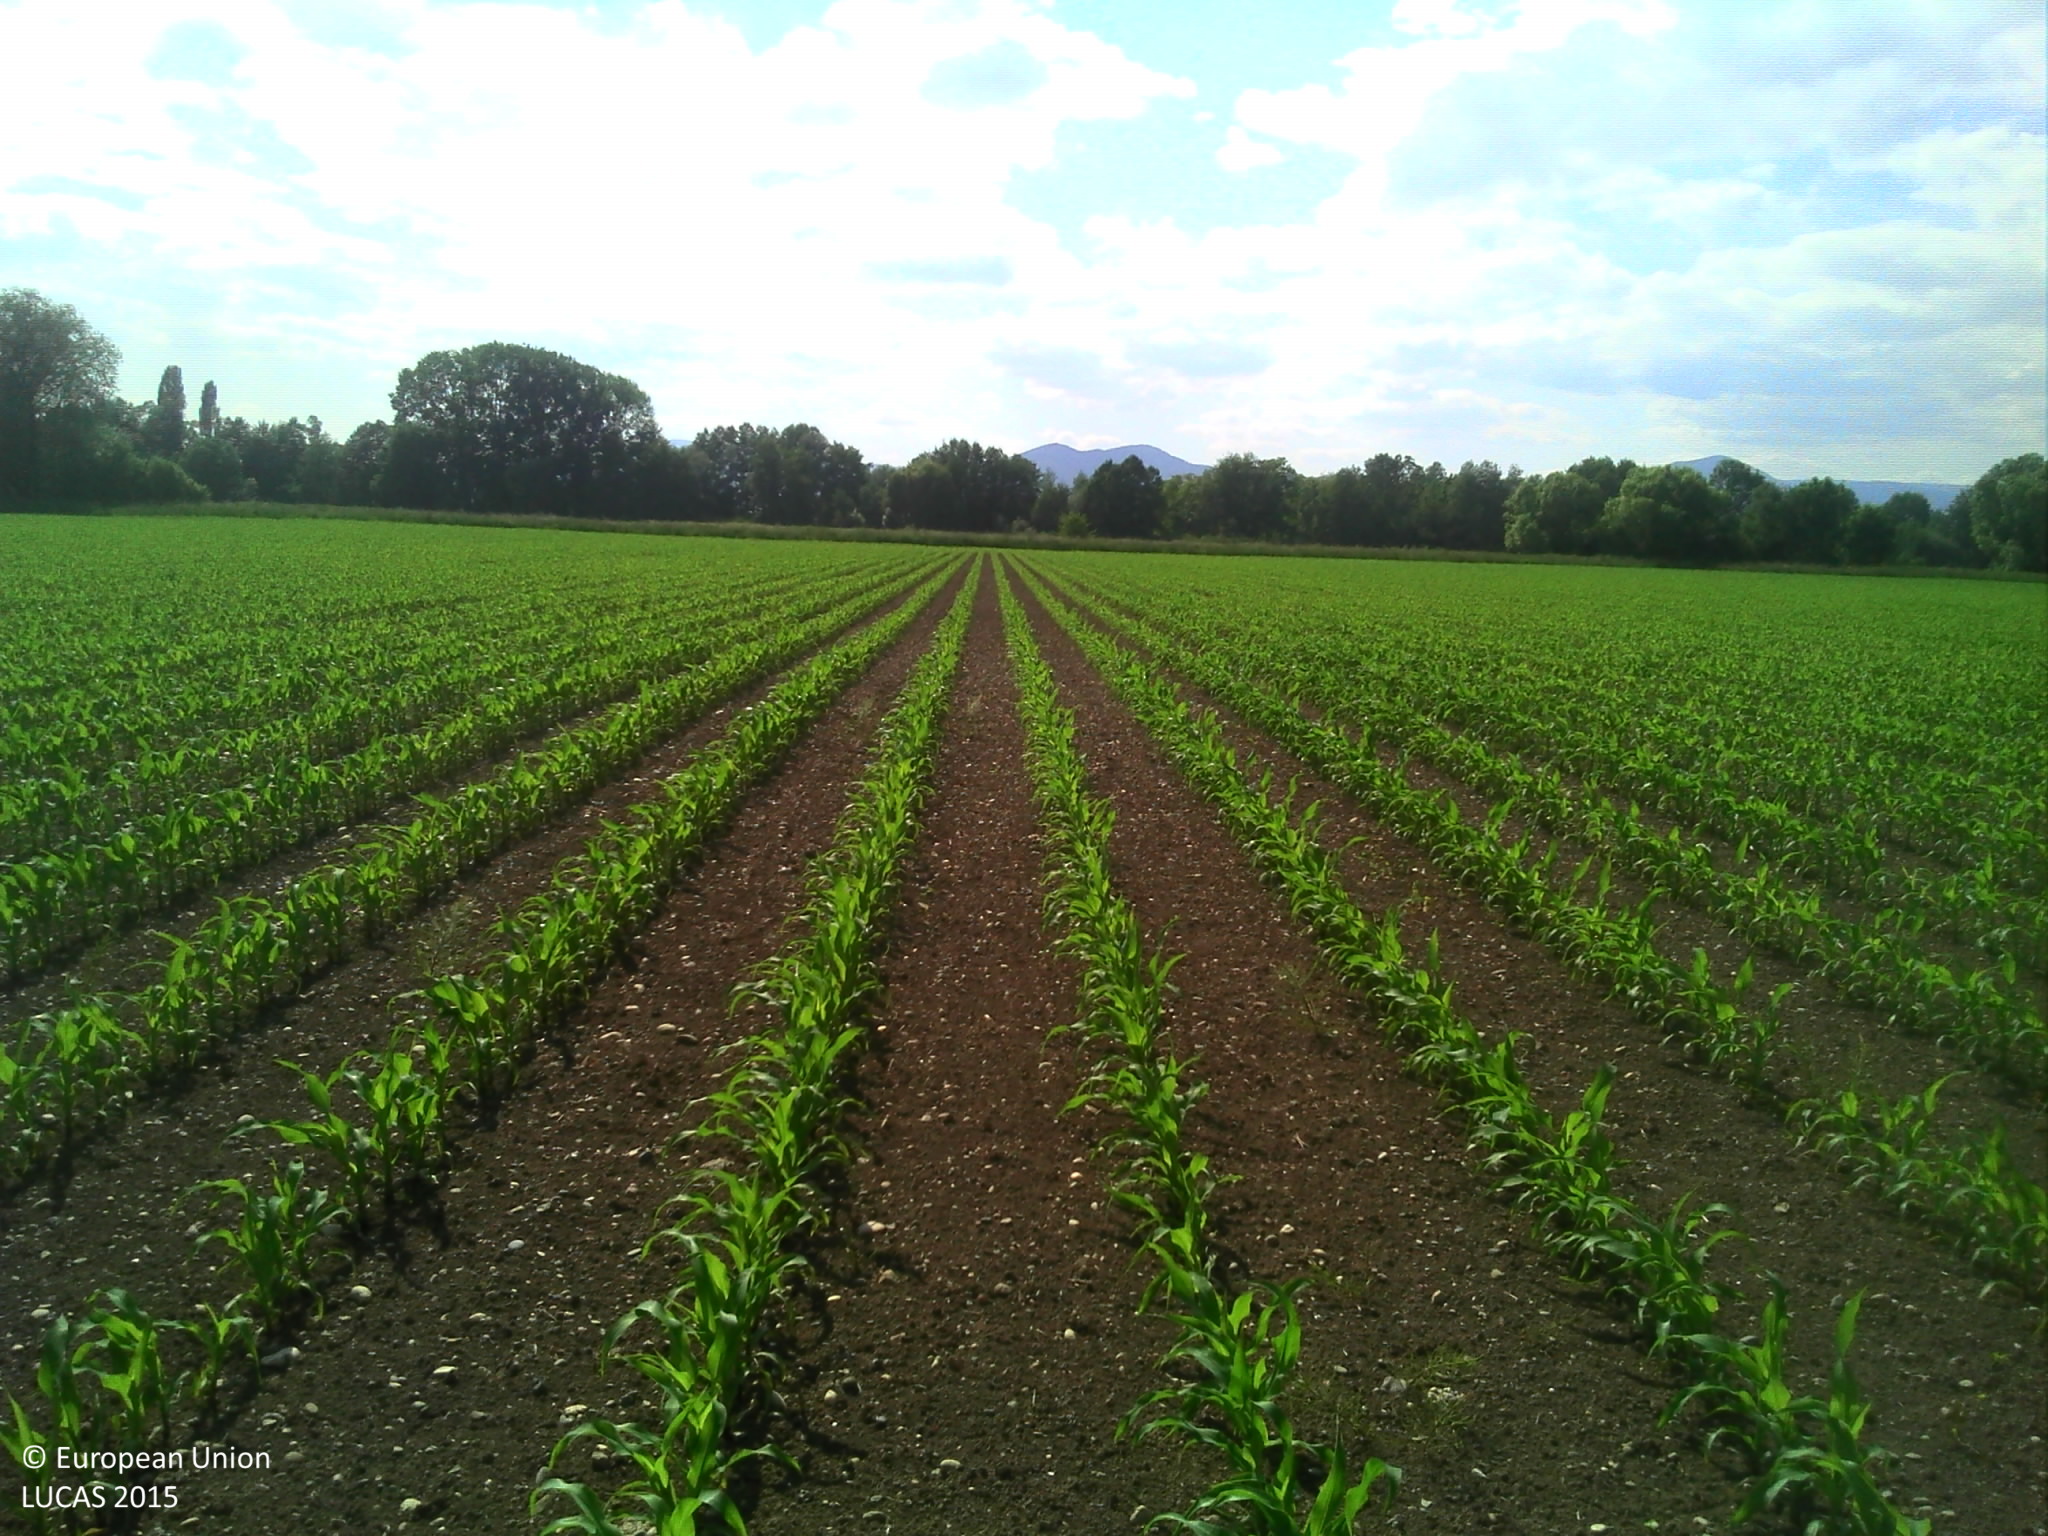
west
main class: Cropland
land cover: Maize
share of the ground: 10 - 25 %
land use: Agriculture (excluding fallow land and kitchen gardens)
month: May
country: FR
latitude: 48.3040
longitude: 7.5338
